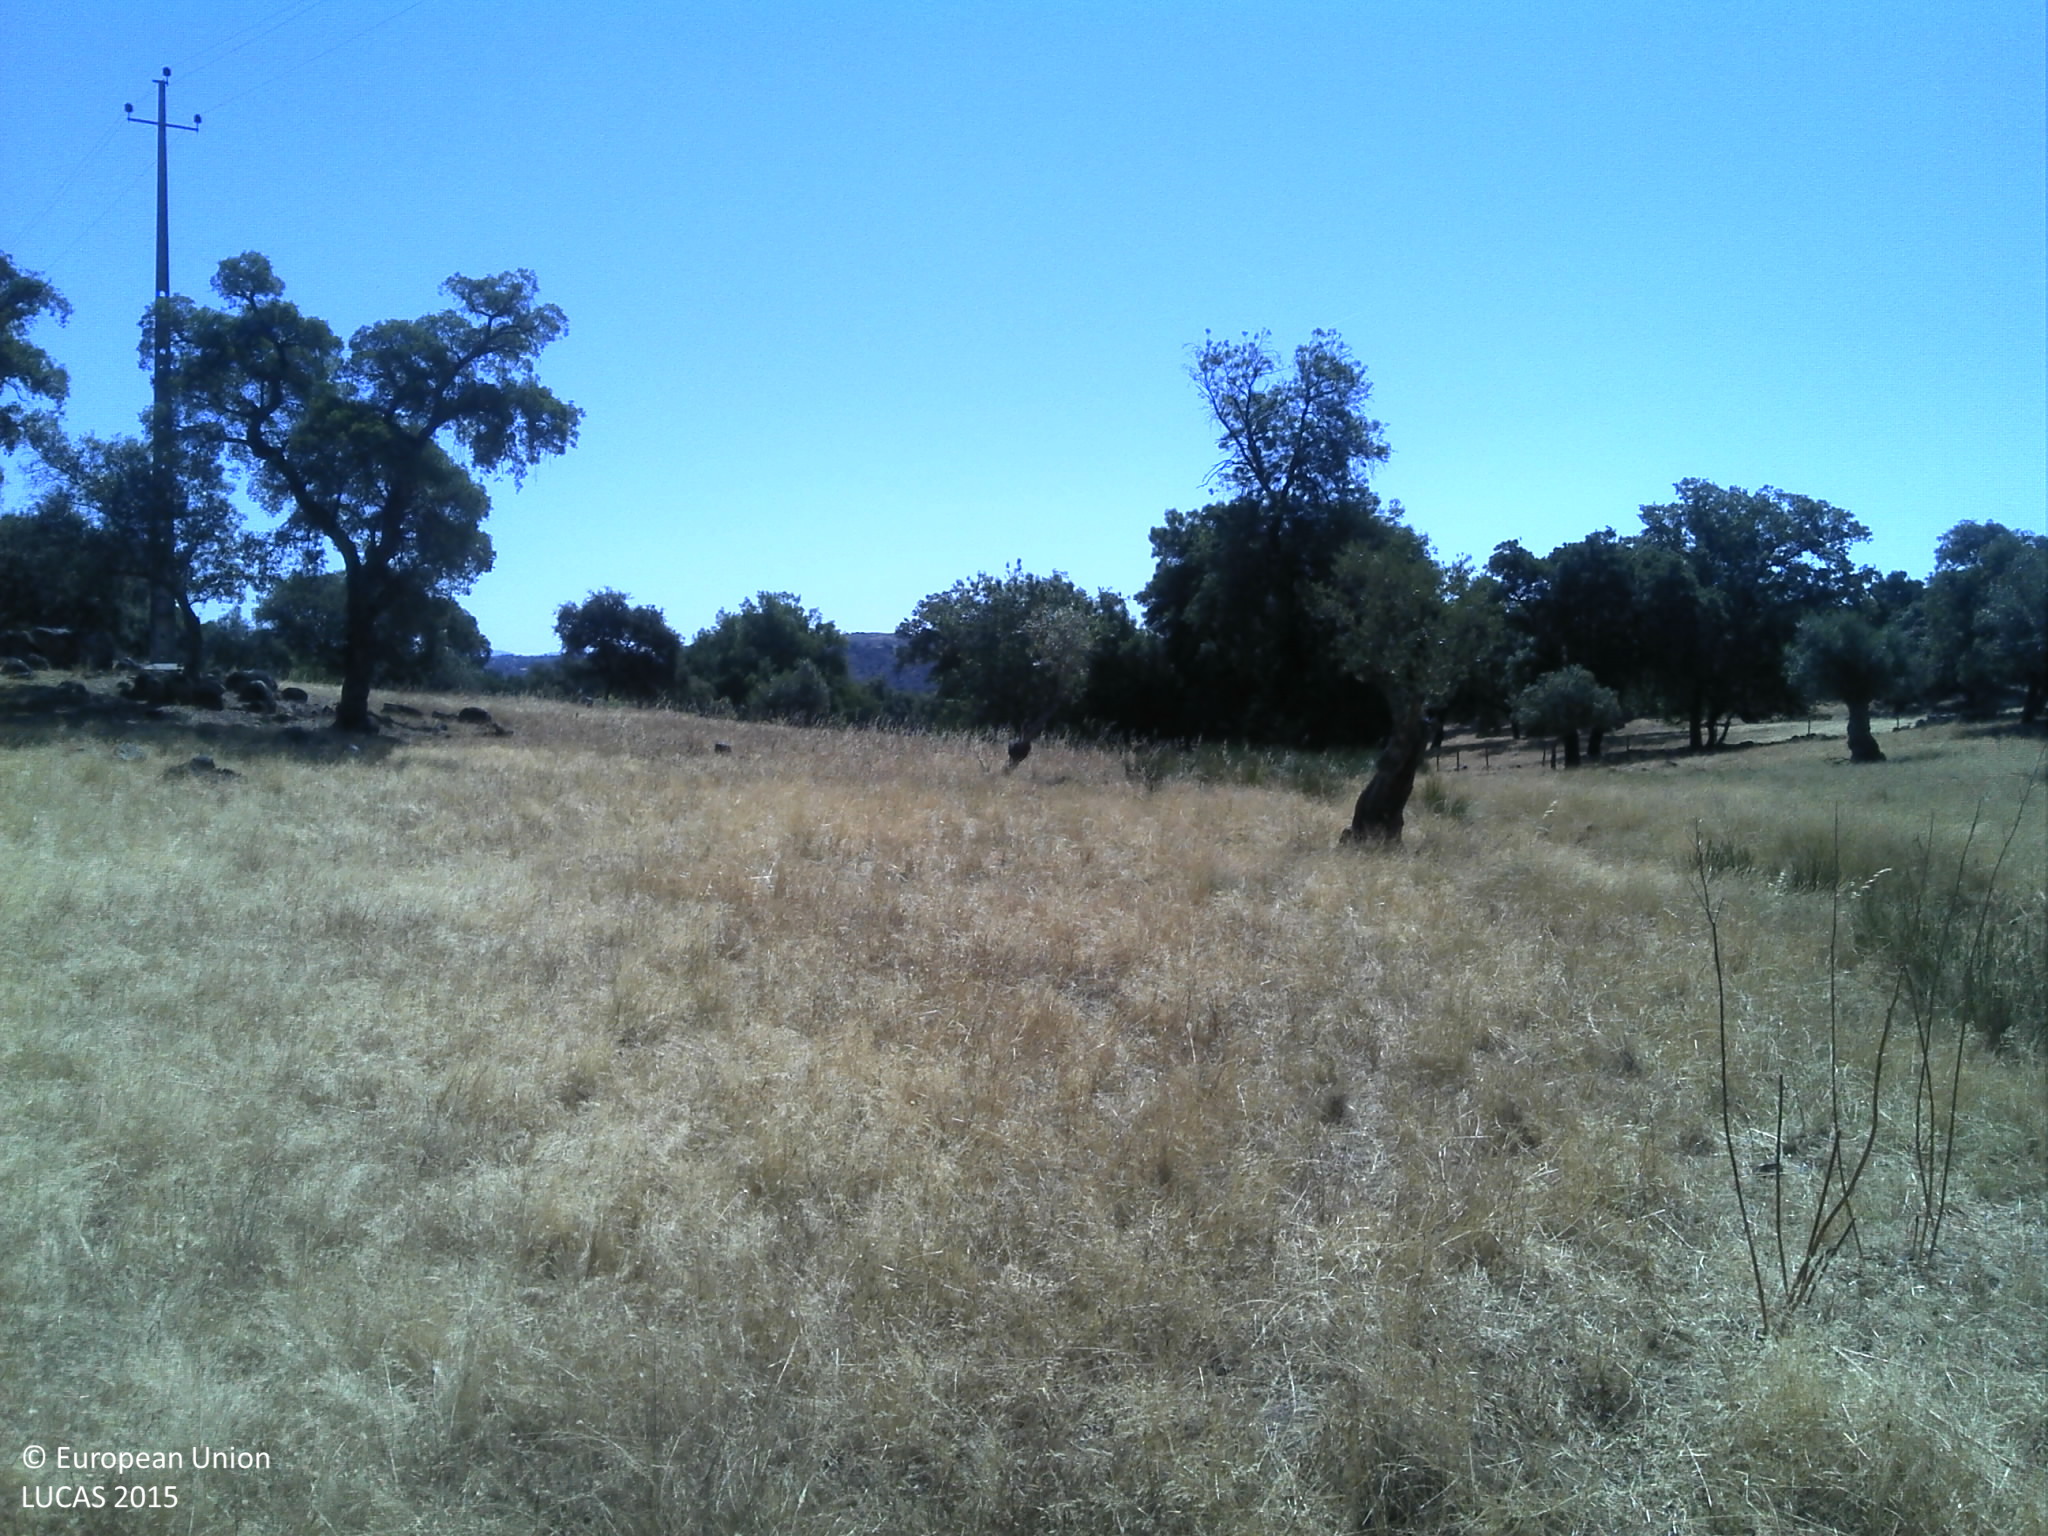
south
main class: Woodland
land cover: Broadleaved woodland
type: broadleaved evergreen forest
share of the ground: 25 - 50 %
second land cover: Grassland without tree/shrub cover
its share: 50 - 75 %
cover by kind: herbaceous plants 50 %, broadleaved forest trees 40 %, unconsolidated bare surface 10 %
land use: Agriculture (excluding fallow land and kitchen gardens)
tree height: > 5 m
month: June
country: PT
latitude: 39.9602
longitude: -7.3654
